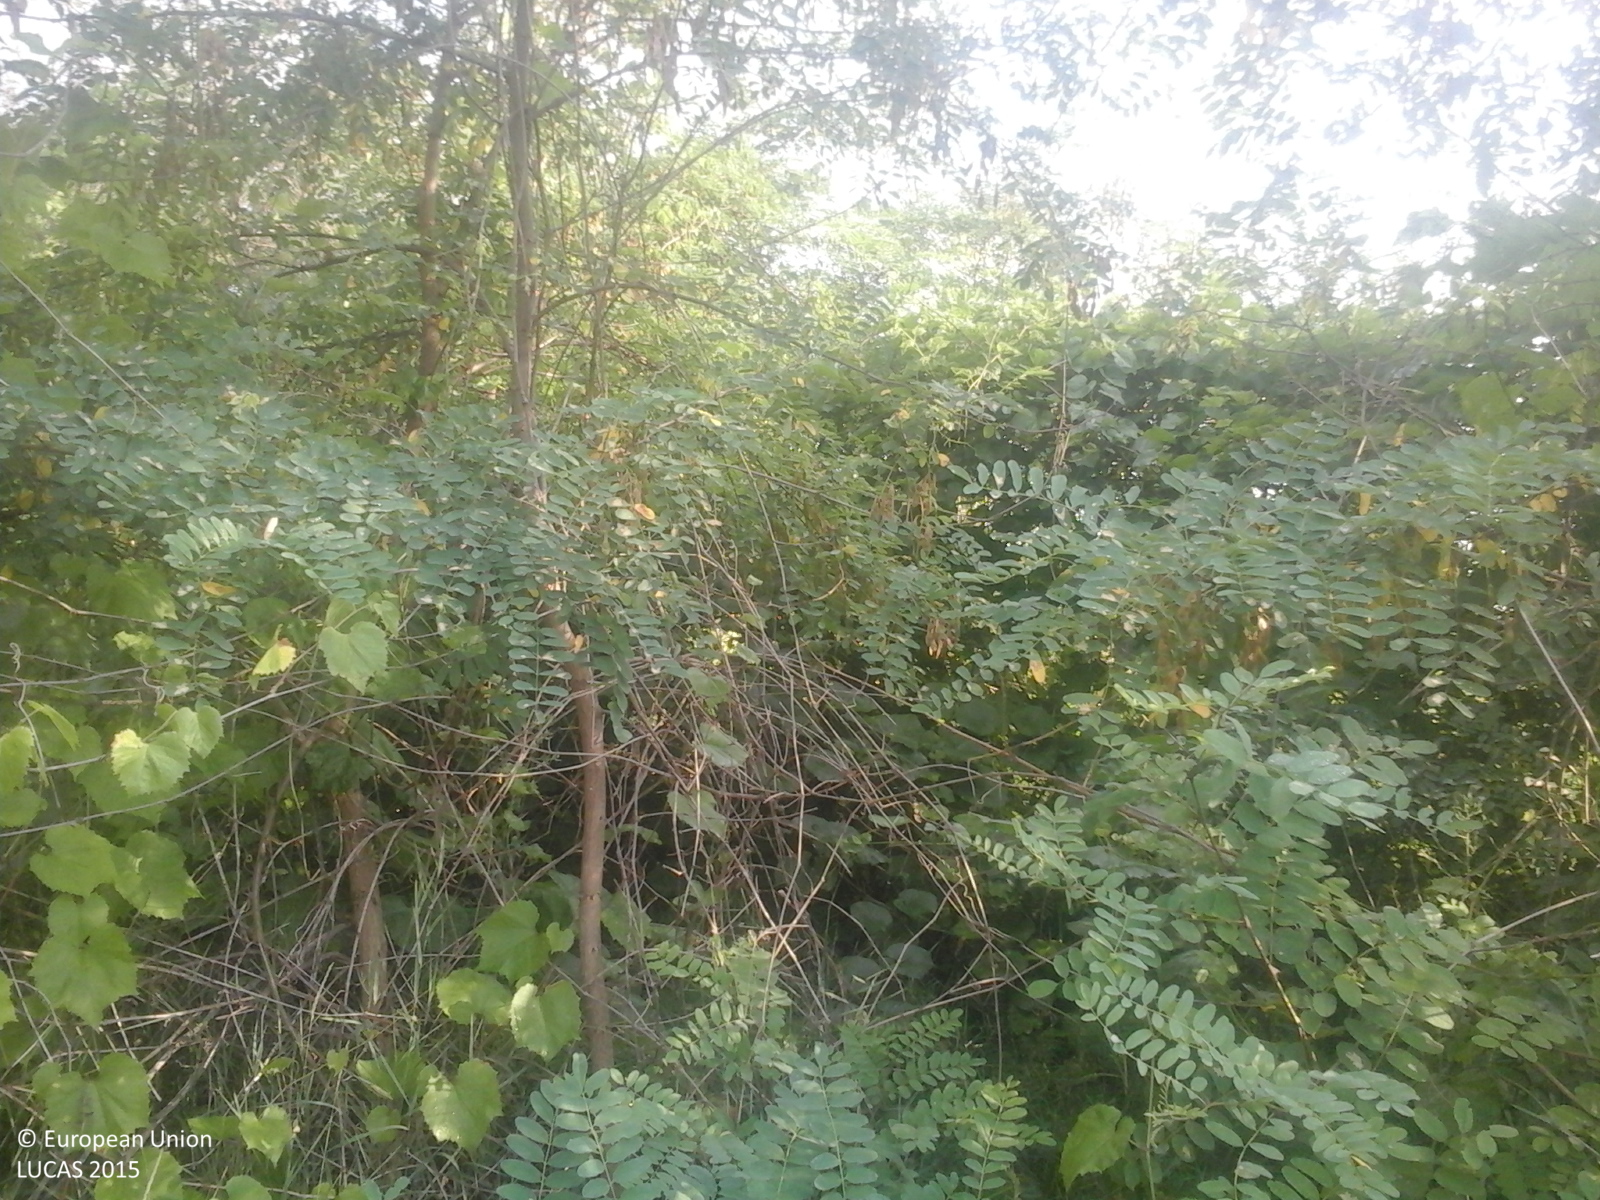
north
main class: Woodland
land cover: Broadleaved woodland
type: exotic forest
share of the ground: > 75 %
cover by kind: broadleaved forest trees 100 %
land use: Semi-natural and natural areas not in use
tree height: > 5 m
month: July
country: RO
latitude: 46.5660
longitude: 27.8518
